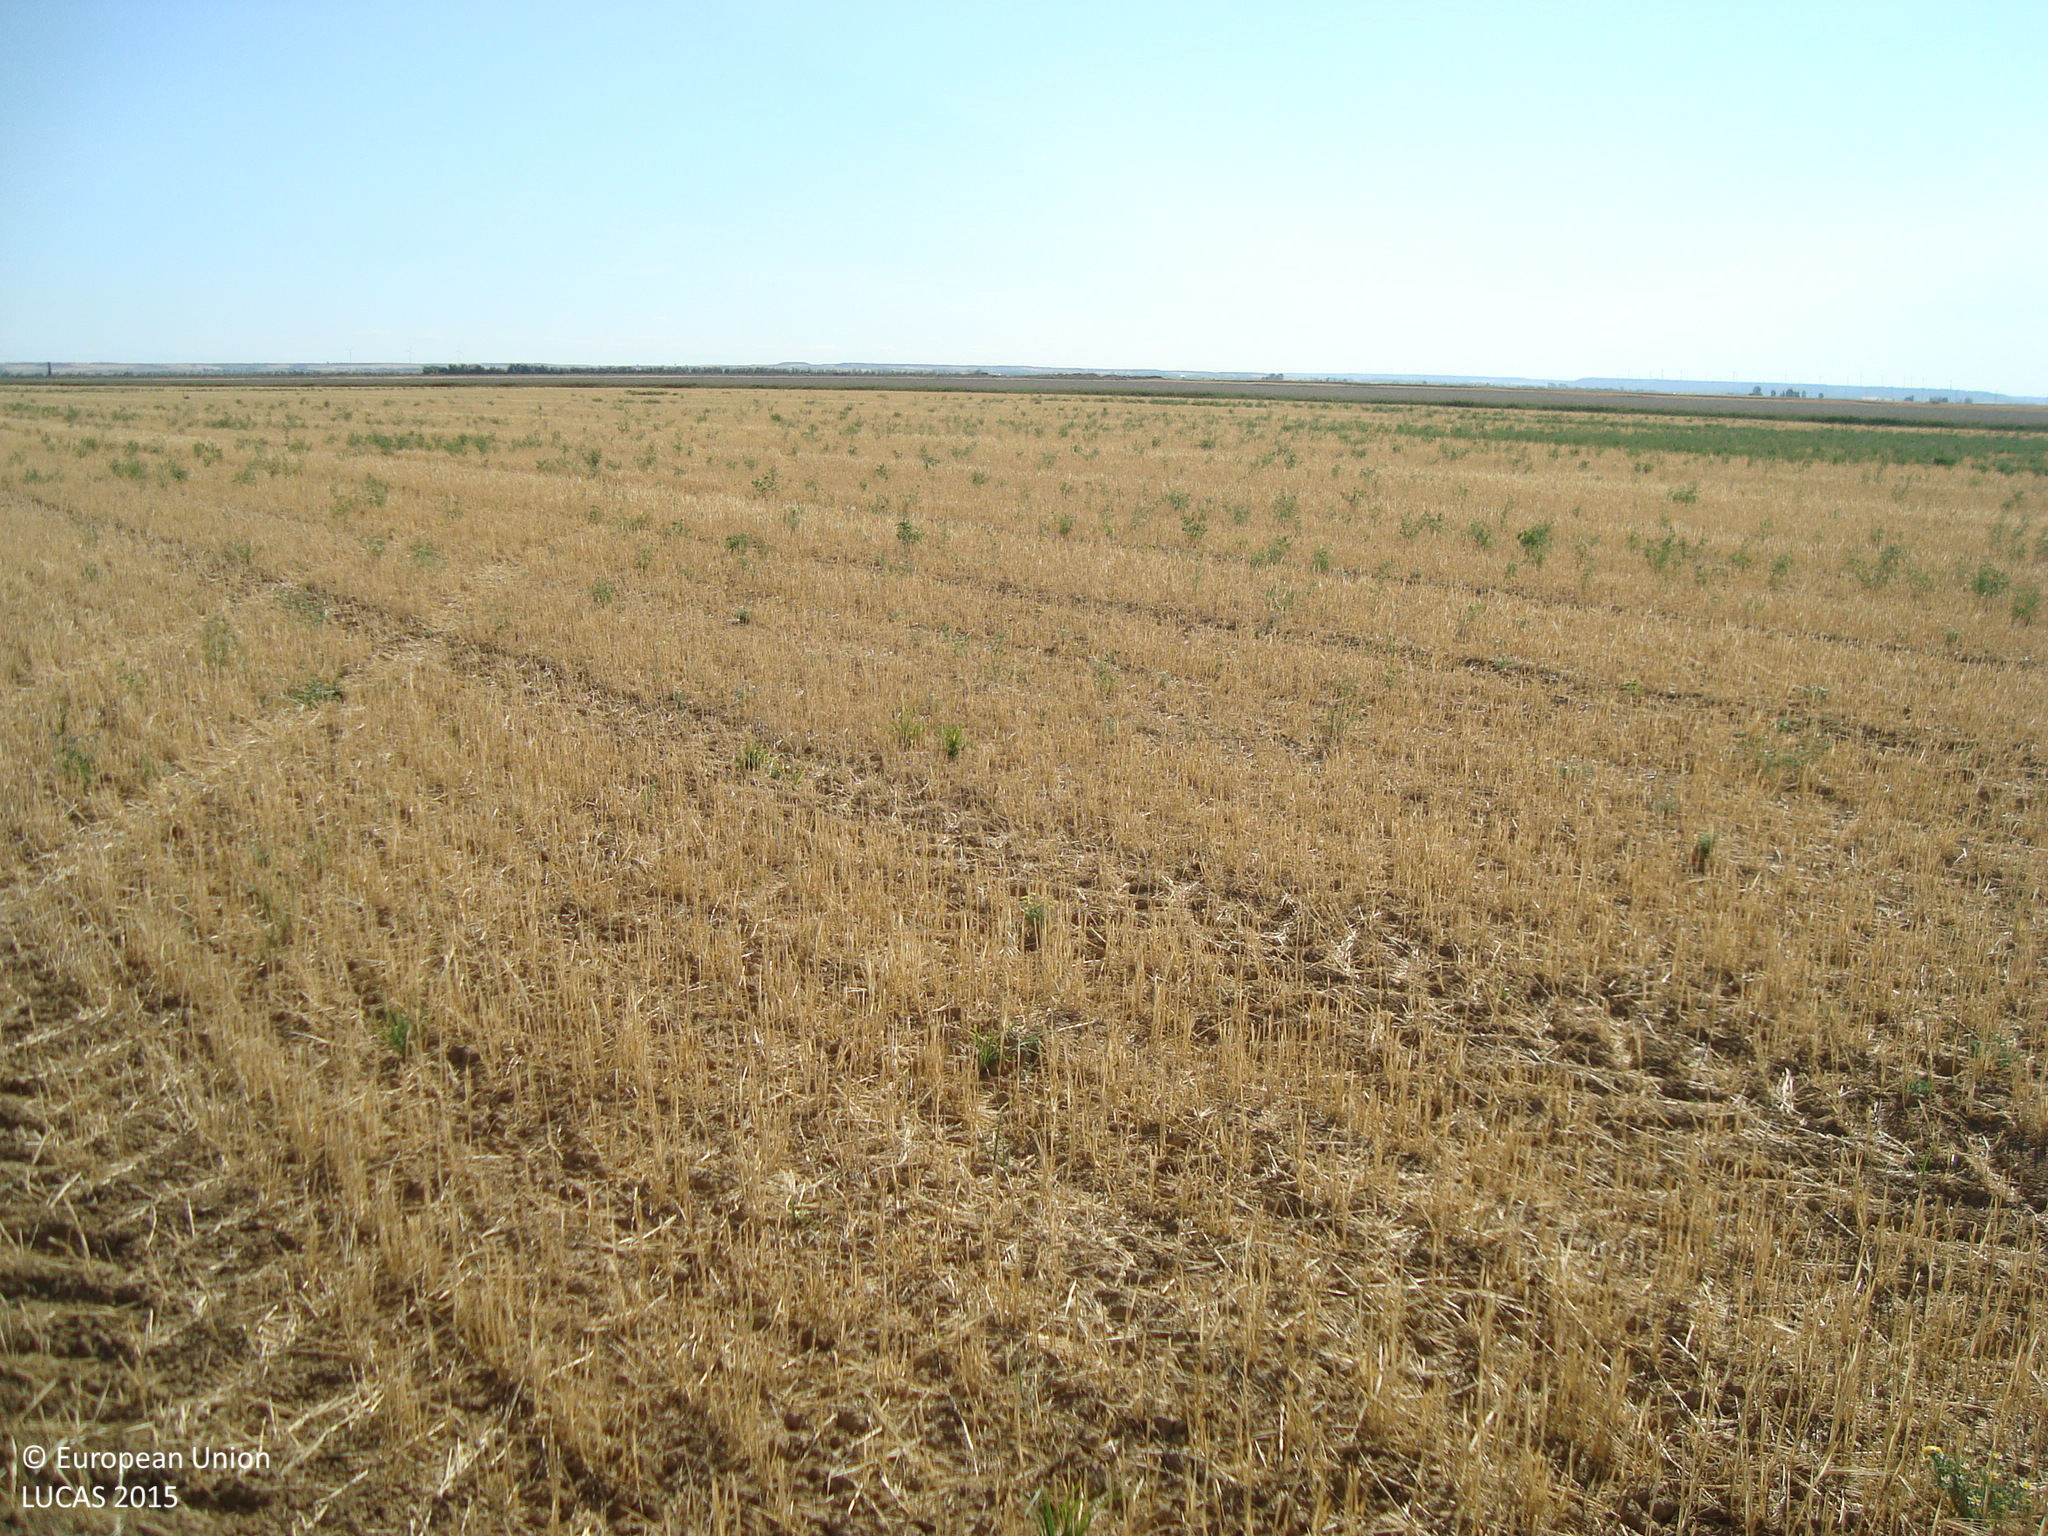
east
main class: Cropland
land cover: Barley
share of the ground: < 10 %
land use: Agriculture (excluding fallow land and kitchen gardens)
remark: Harvested field
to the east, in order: Barley; Grass margins; Ditches and canals; Grass margins; Lucerne
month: July
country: ES
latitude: 42.0434
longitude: -4.7529
